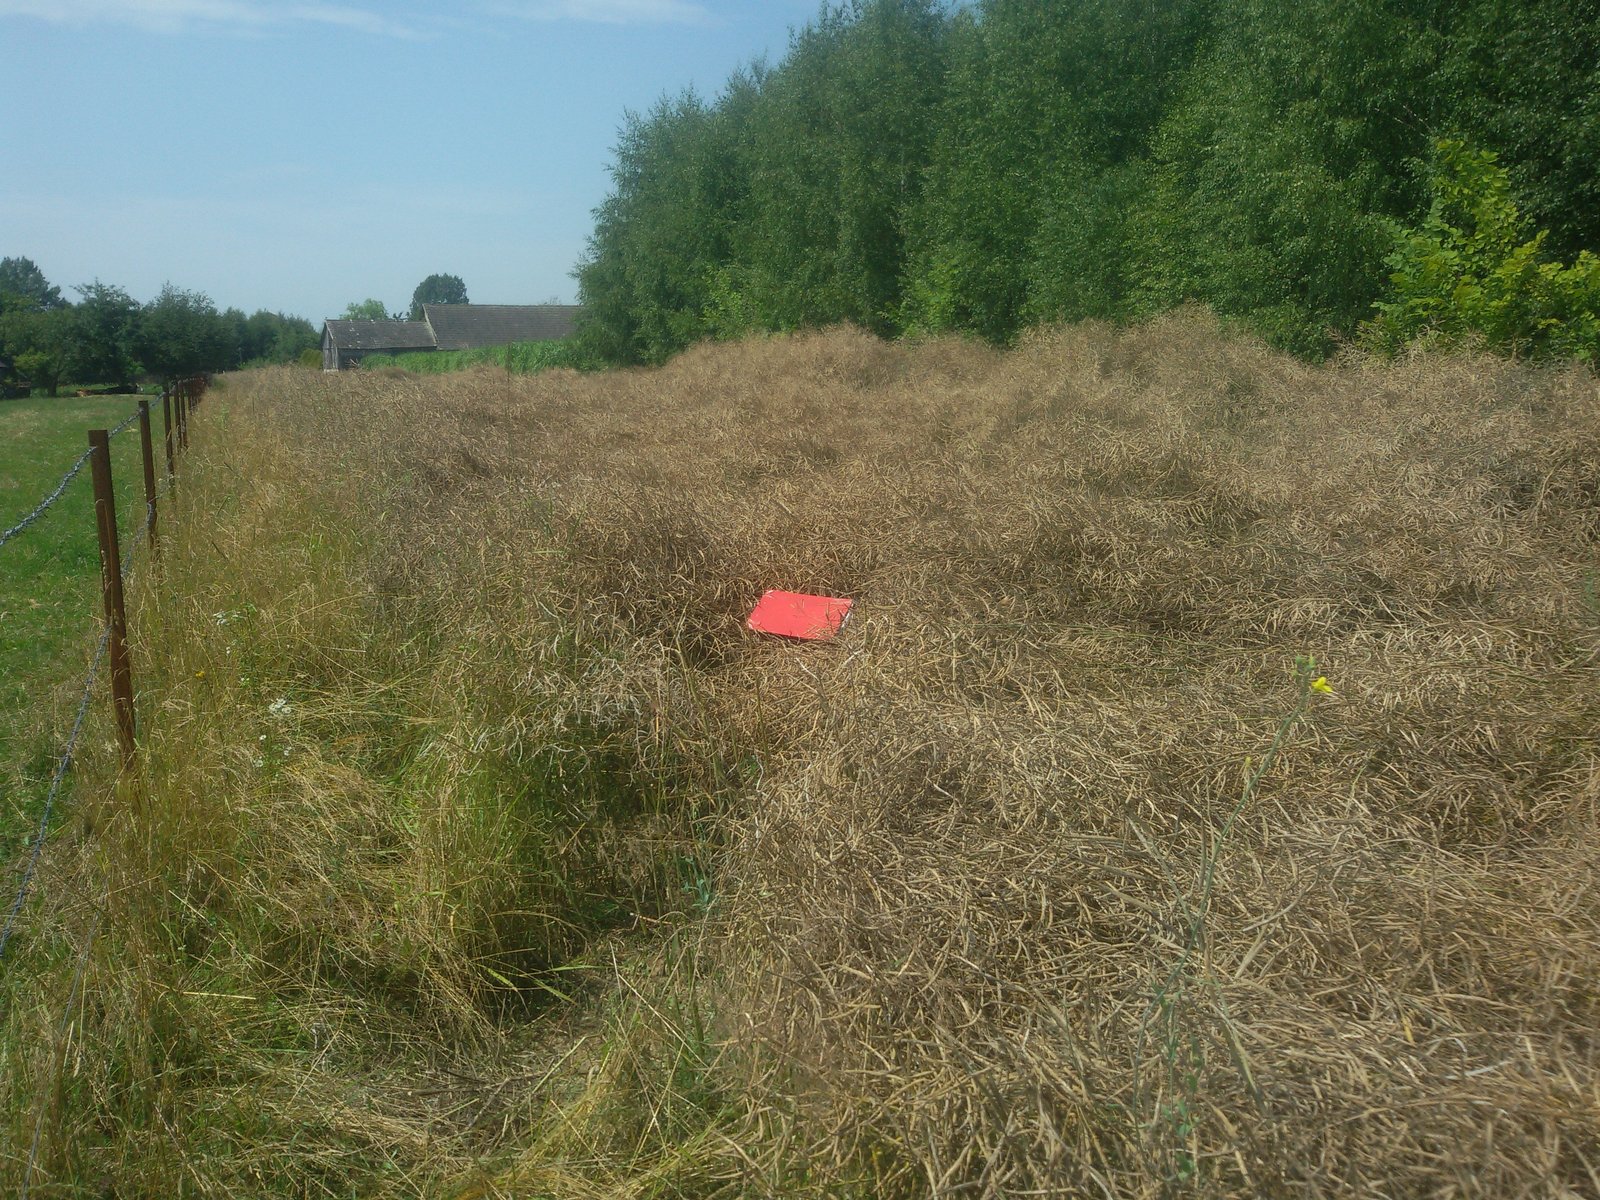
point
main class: Cropland
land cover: Rape and turnip rape
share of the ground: > 75 %
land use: Agriculture (excluding fallow land and kitchen gardens)
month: July
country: PL
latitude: 50.3042
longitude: 22.4054
